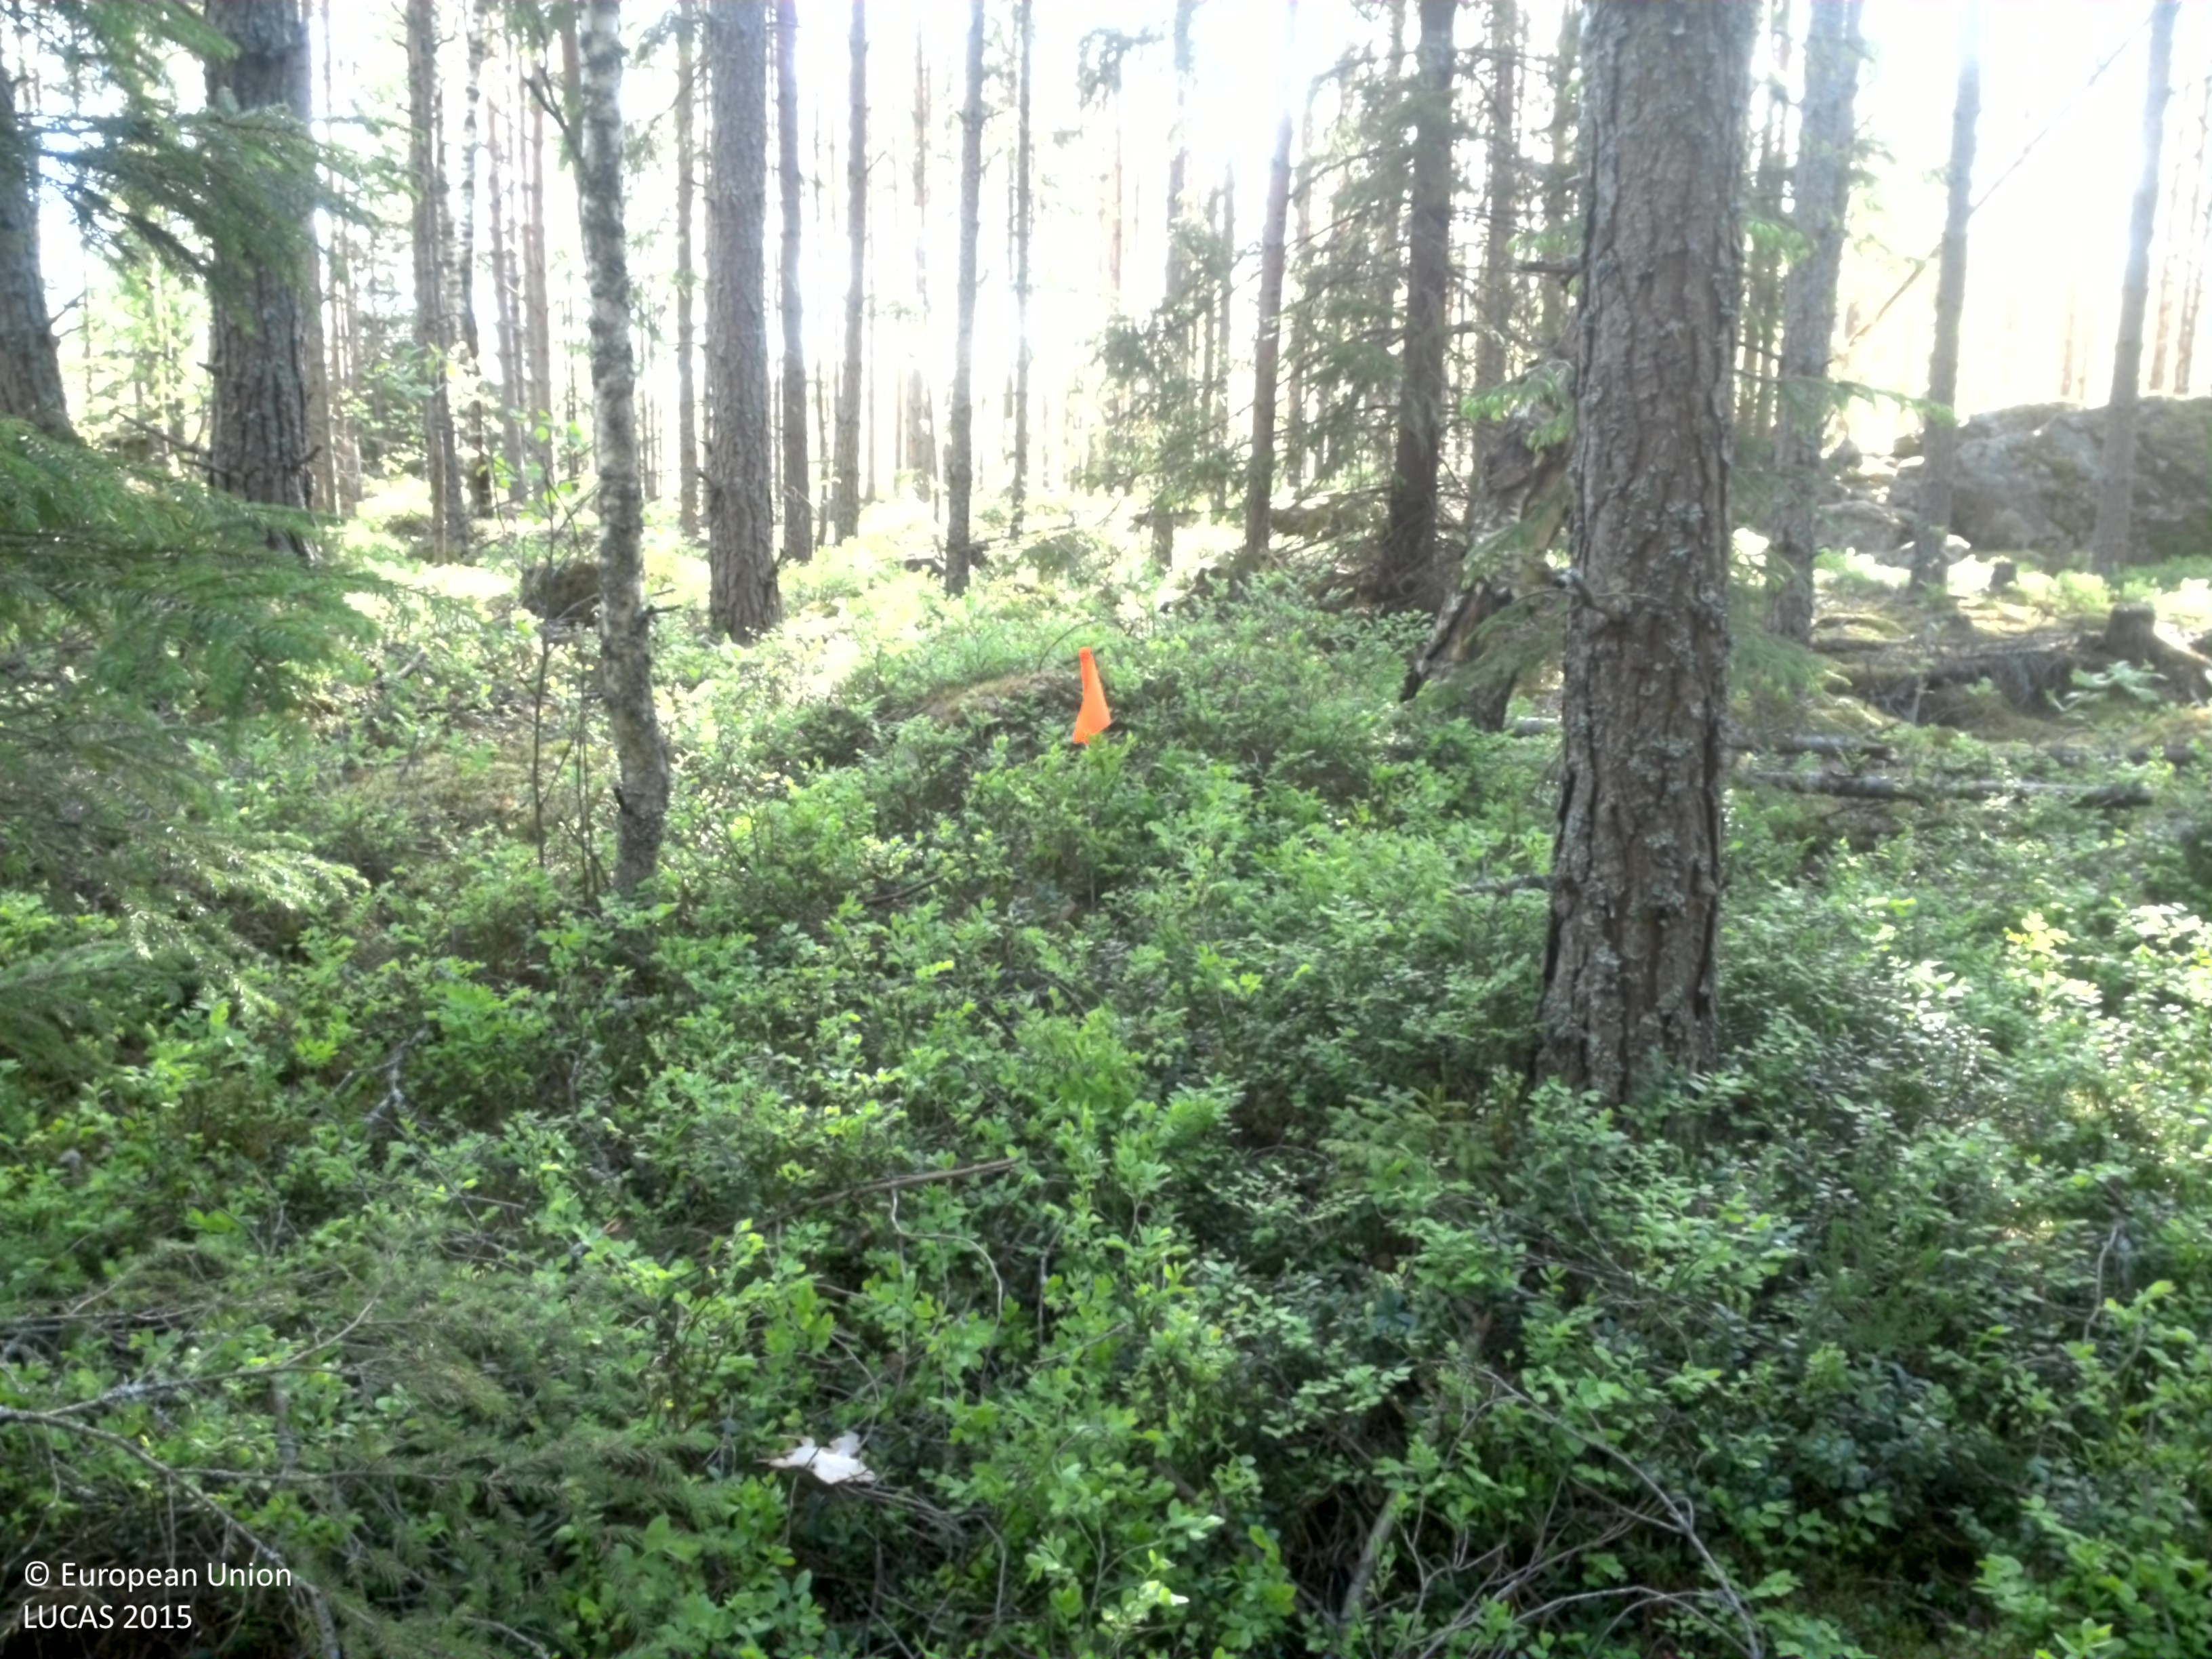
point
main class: Woodland
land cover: Pine dominated mixed woodland
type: boreal forest
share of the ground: 50 - 75 %
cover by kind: coniferous forest trees 40 %, broadleaved forest trees 25 %, shrubs 15 %, lichens and mosses 10 %, consolidated bare surface 10 %
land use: Forestry
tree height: > 5 m
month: June
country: SE
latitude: 59.2660
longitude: 14.3598
